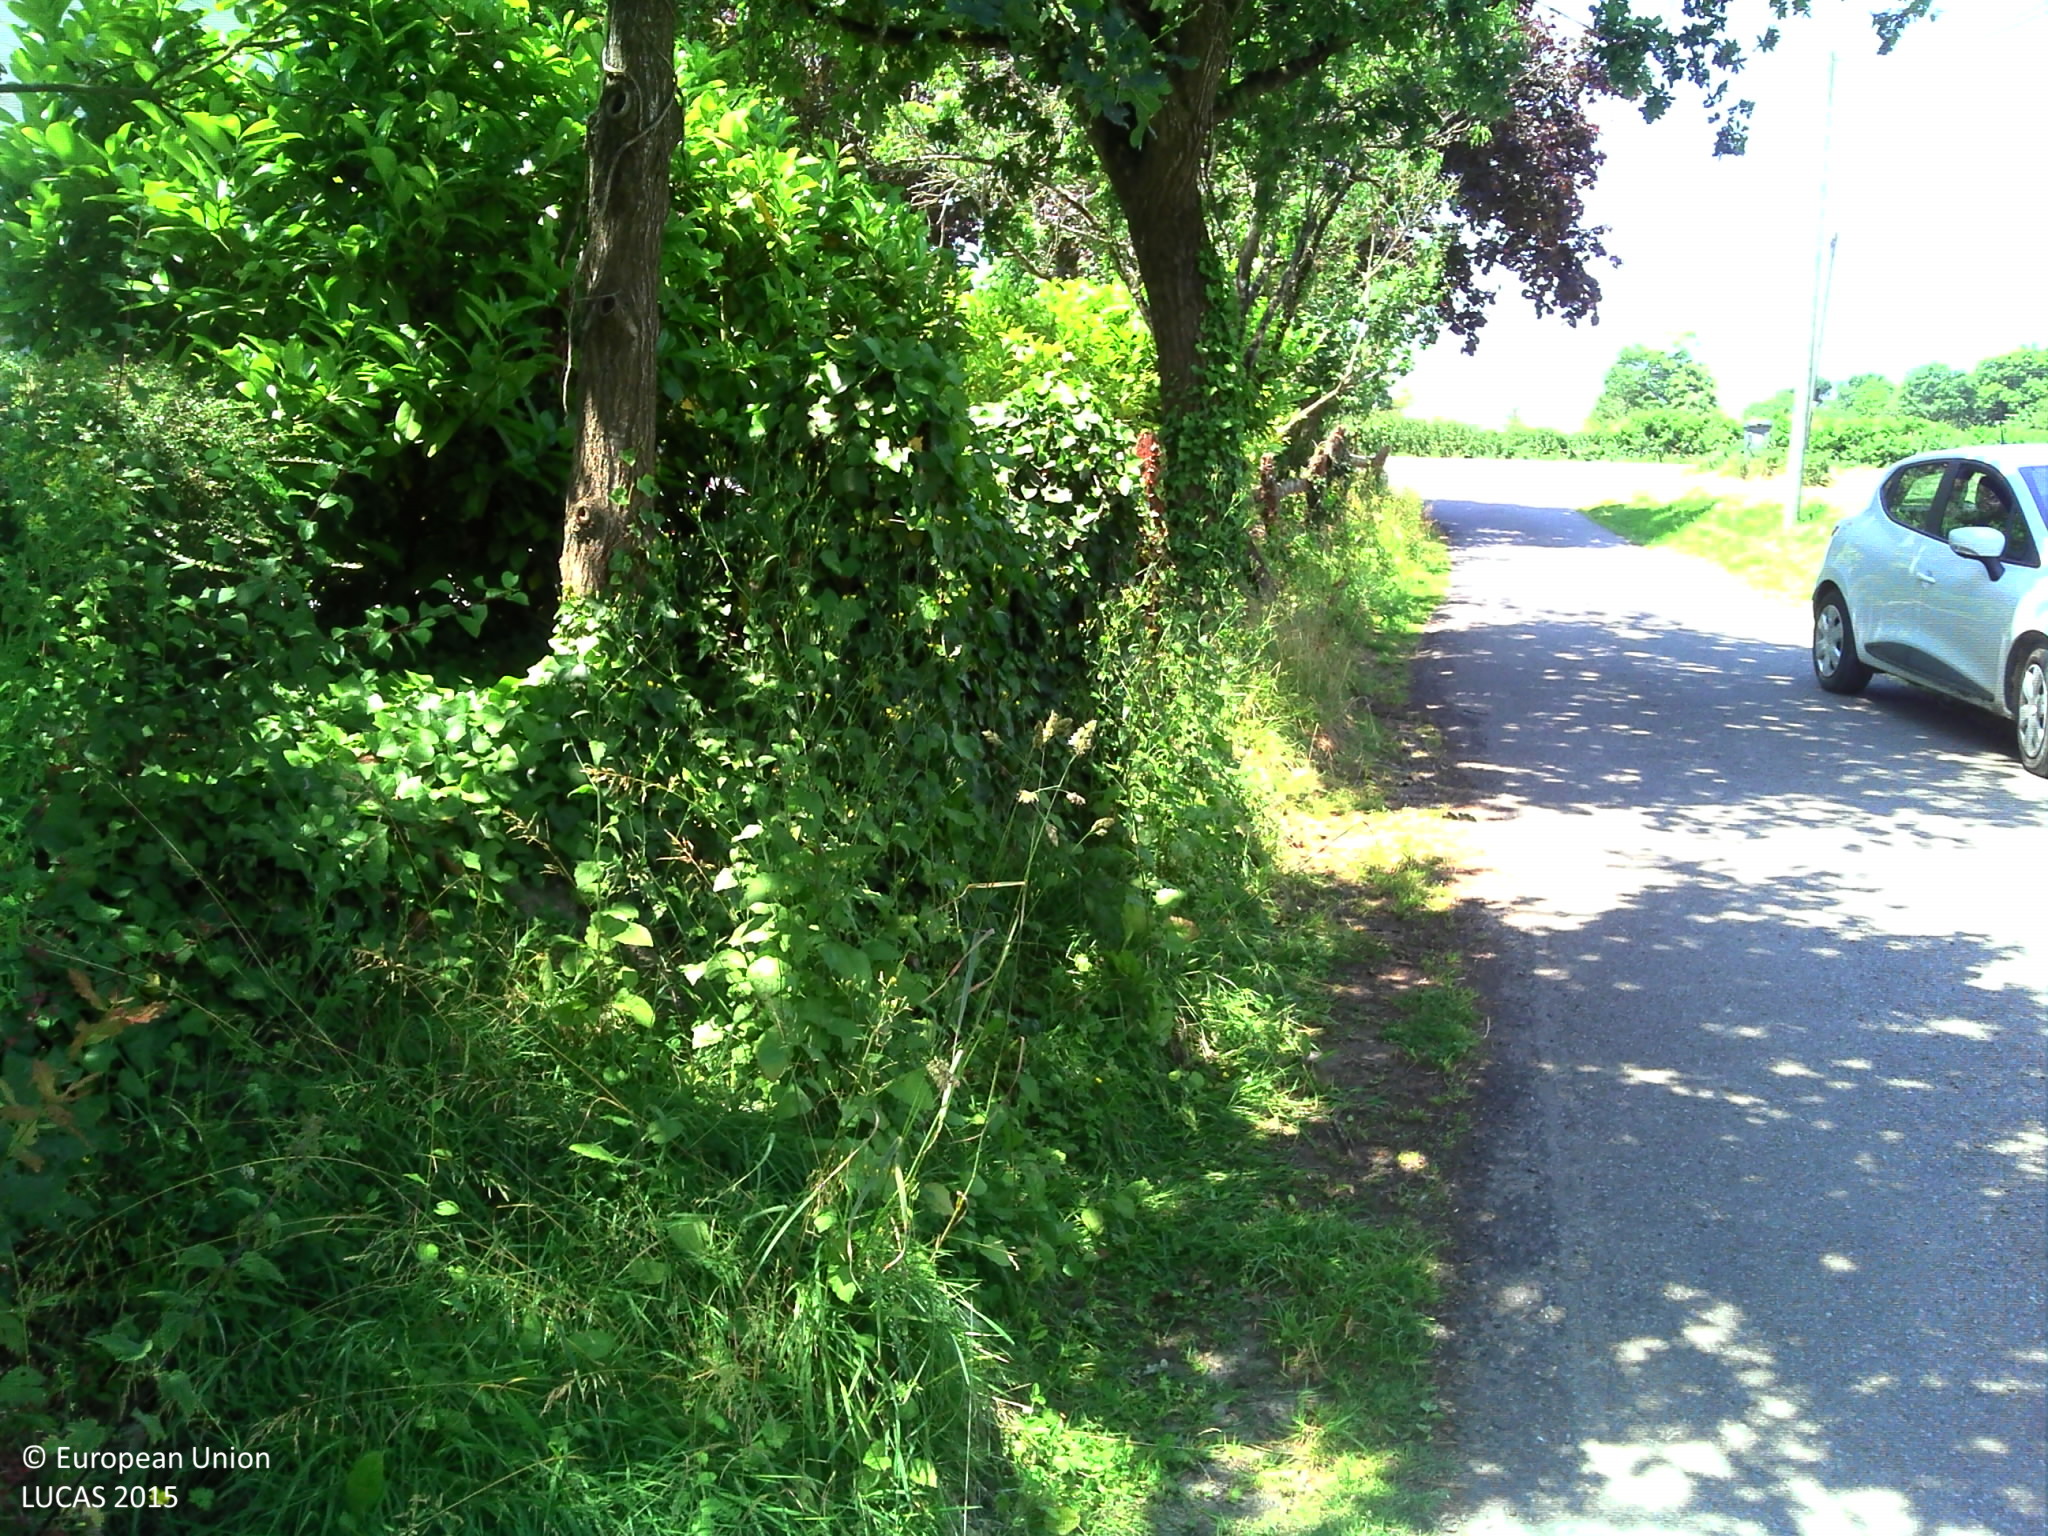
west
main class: Grassland
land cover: Grassland with sparse tree/shrub cover
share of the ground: > 75 %
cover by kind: herbaceous plants 95 %, broadleaved forest trees 5 %
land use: Residential
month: June
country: FR
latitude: 48.0427
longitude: -1.6229
